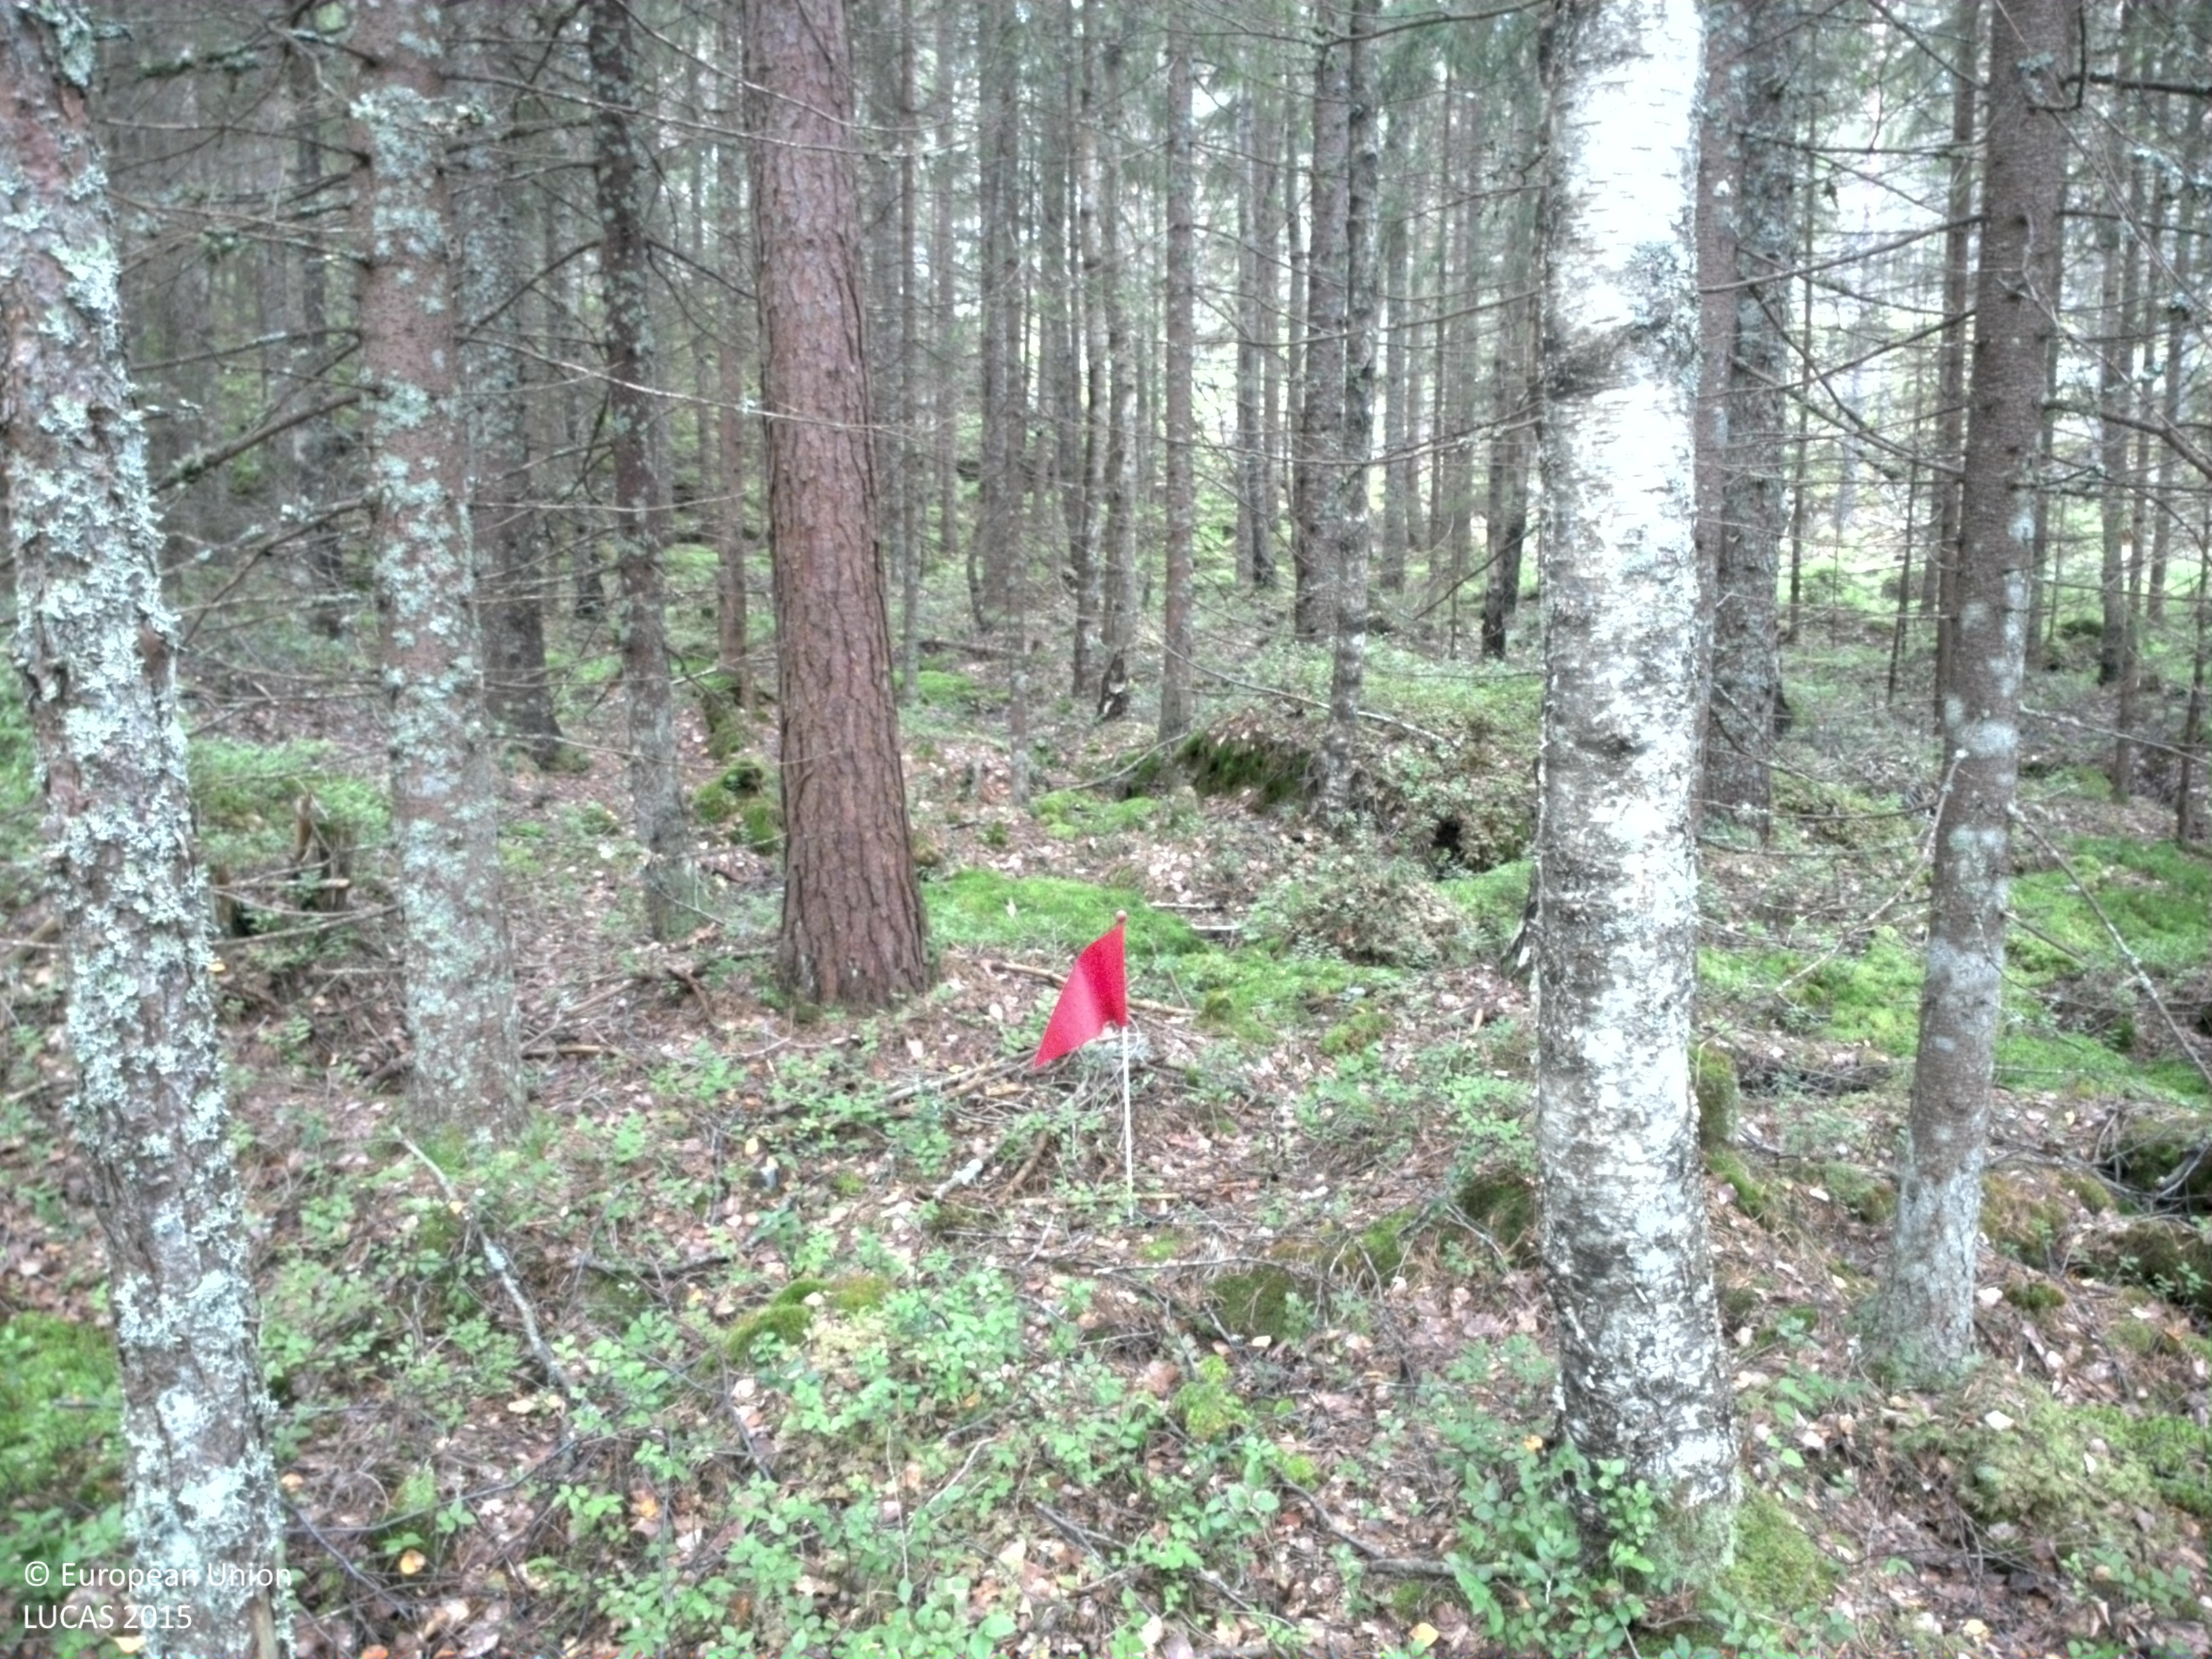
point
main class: Woodland
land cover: Spruce dominated coniferous woodland
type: boreal forest
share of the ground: 50 - 75 %
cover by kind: coniferous forest trees 65 %, lichens and mosses 20 %, shrubs 10 %, broadleaved forest trees 5 %
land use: Forestry
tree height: > 5 m
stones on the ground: < 10 %
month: August
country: SE
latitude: 59.2501
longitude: 11.8715
